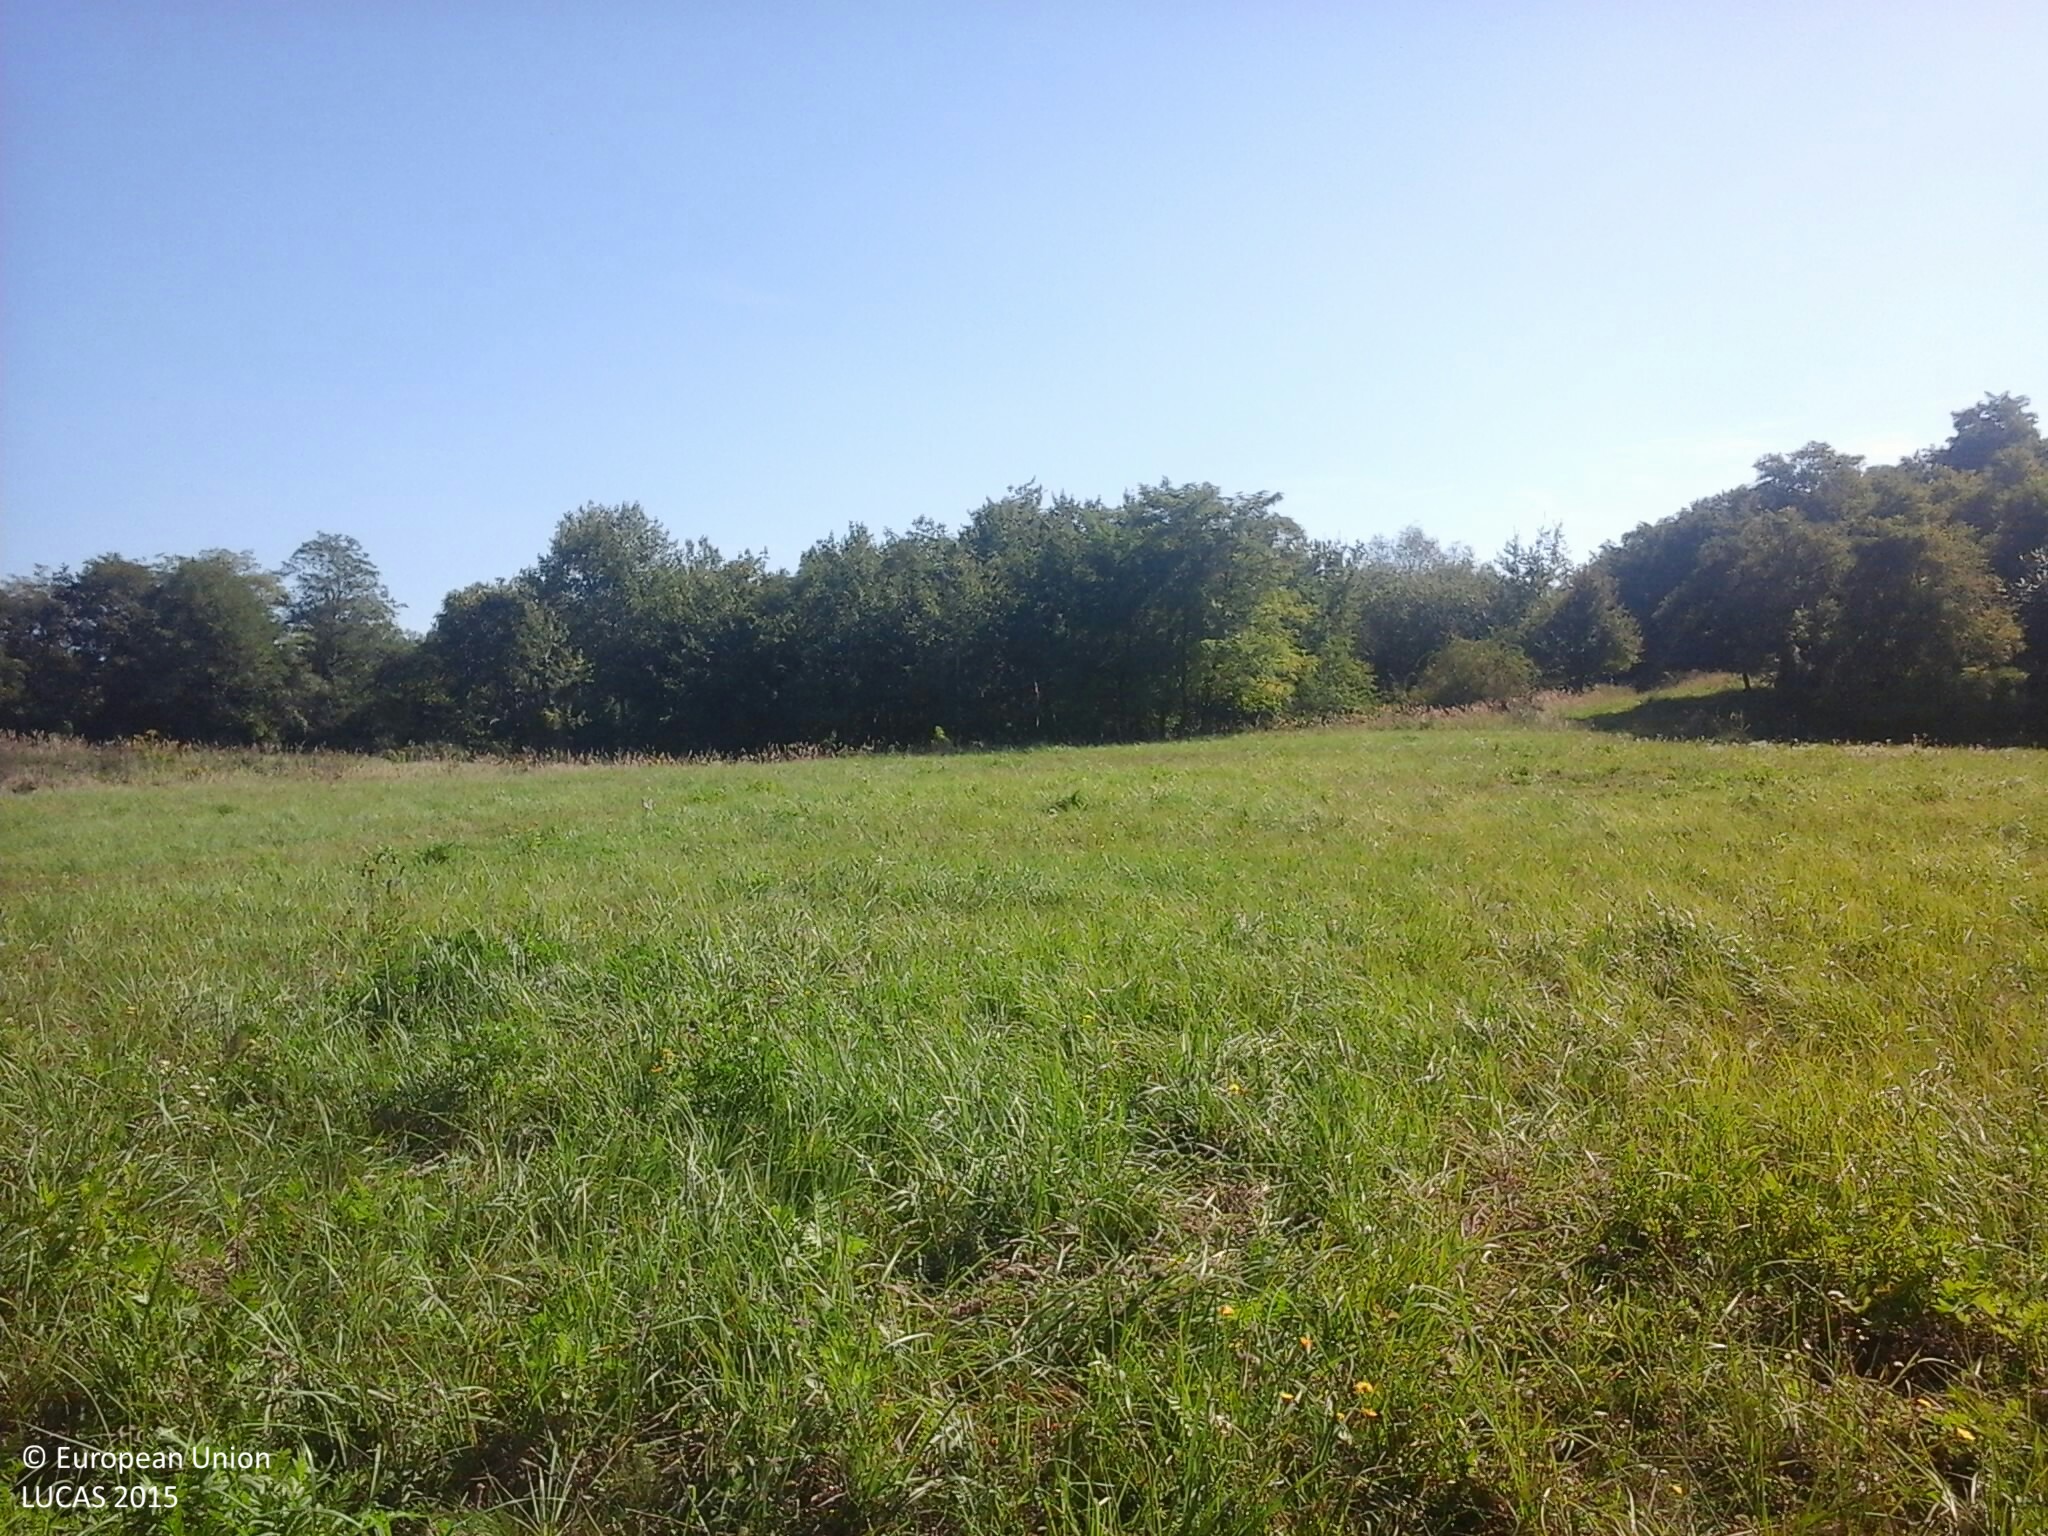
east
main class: Grassland
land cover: Grassland without tree/shrub cover
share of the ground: > 75 %
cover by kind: herbaceous plants 100 %
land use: Agriculture (excluding fallow land and kitchen gardens)
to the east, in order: Grassland without tree/shrub cover; Shrubland with sparse tree cover; Broadleaved woodland
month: September
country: HU
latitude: 48.0499
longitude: 19.8874
